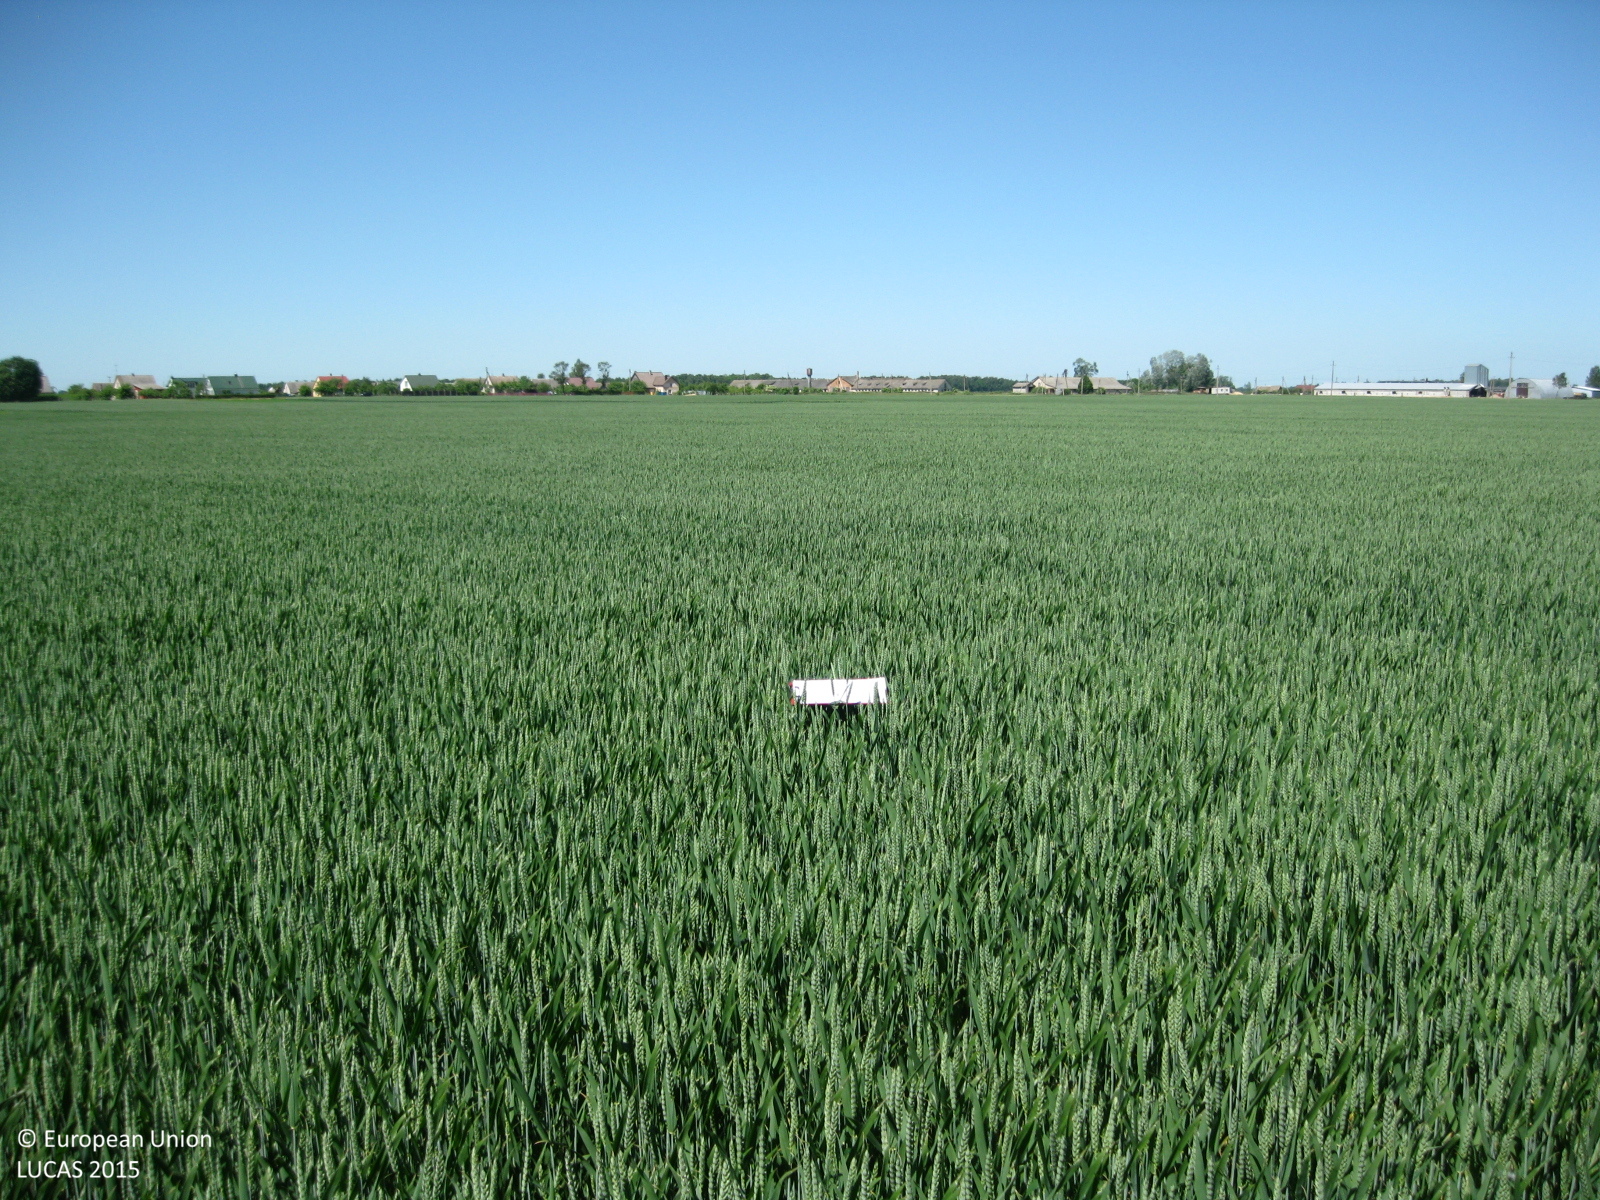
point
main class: Cropland
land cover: Common wheat
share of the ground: > 75 %
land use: Agriculture (excluding fallow land and kitchen gardens)
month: June
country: LT
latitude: 55.6779
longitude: 24.2633
